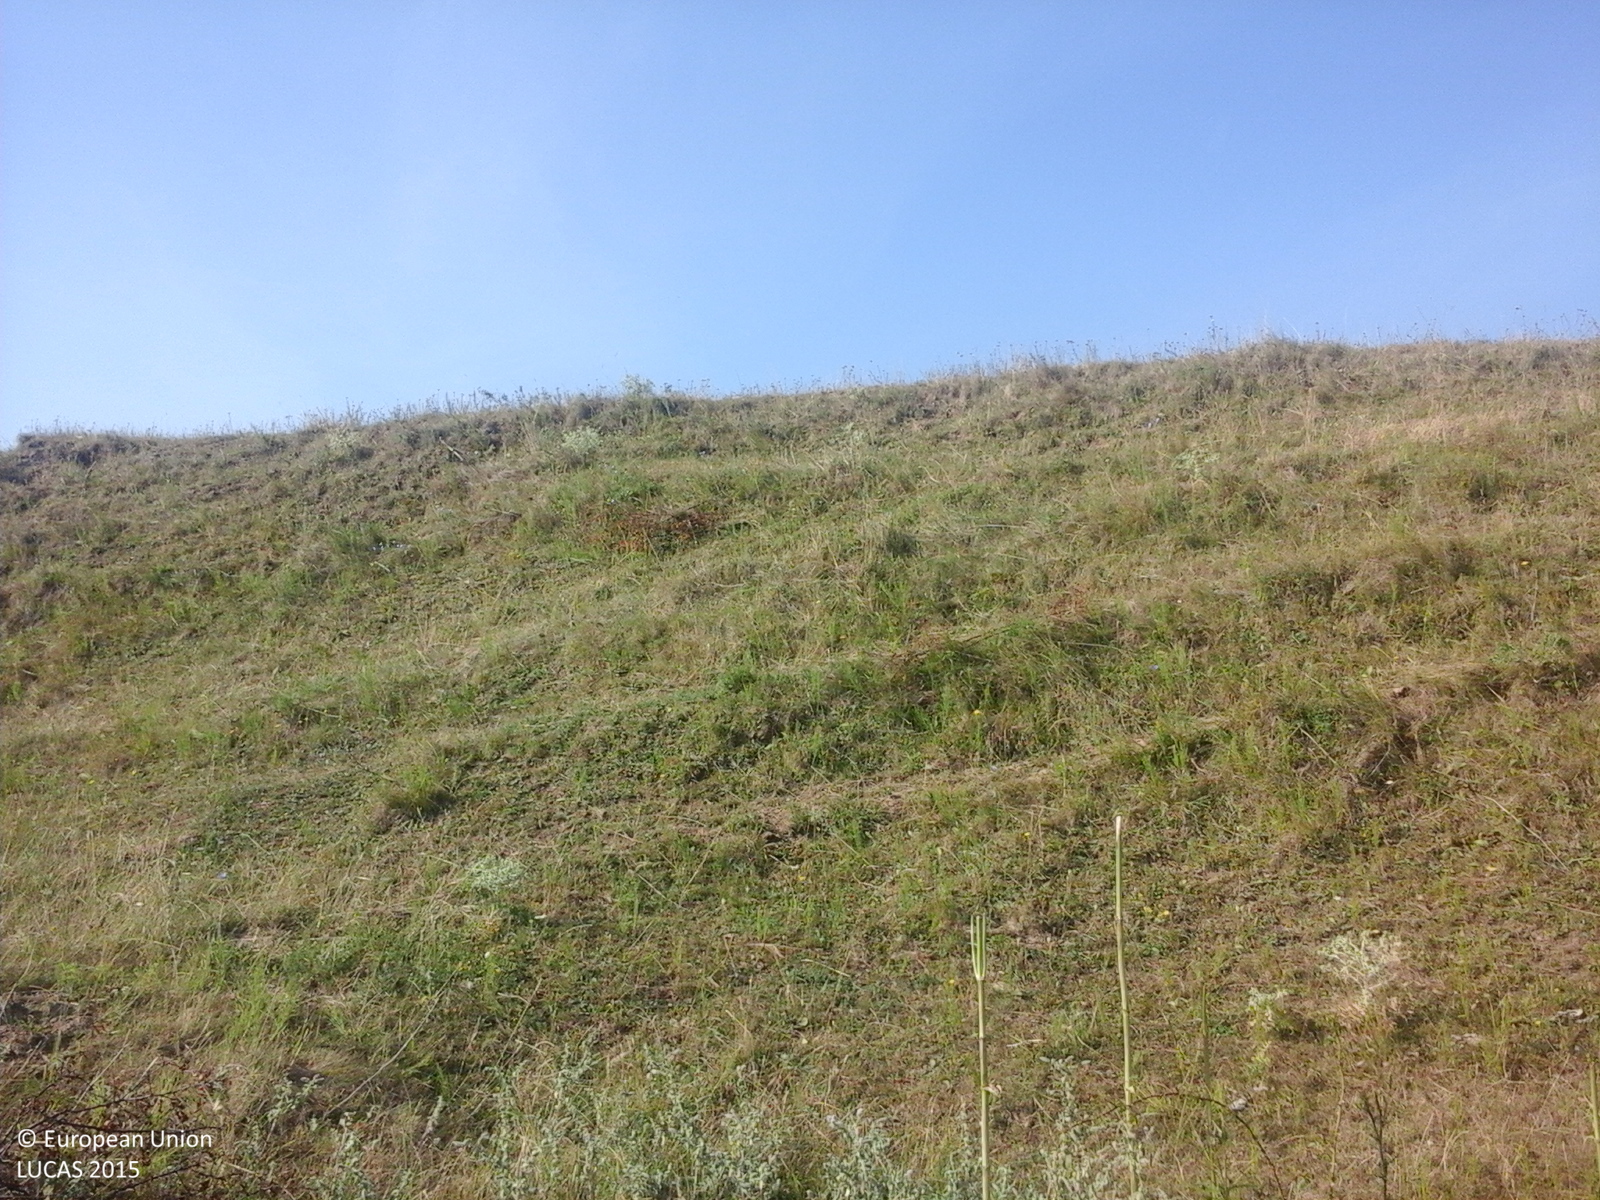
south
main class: Grassland
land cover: Grassland without tree/shrub cover
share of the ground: > 75 %
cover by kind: herbaceous plants 100 %
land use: Agriculture (excluding fallow land and kitchen gardens)
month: July
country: RO
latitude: 46.2111
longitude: 27.3295
